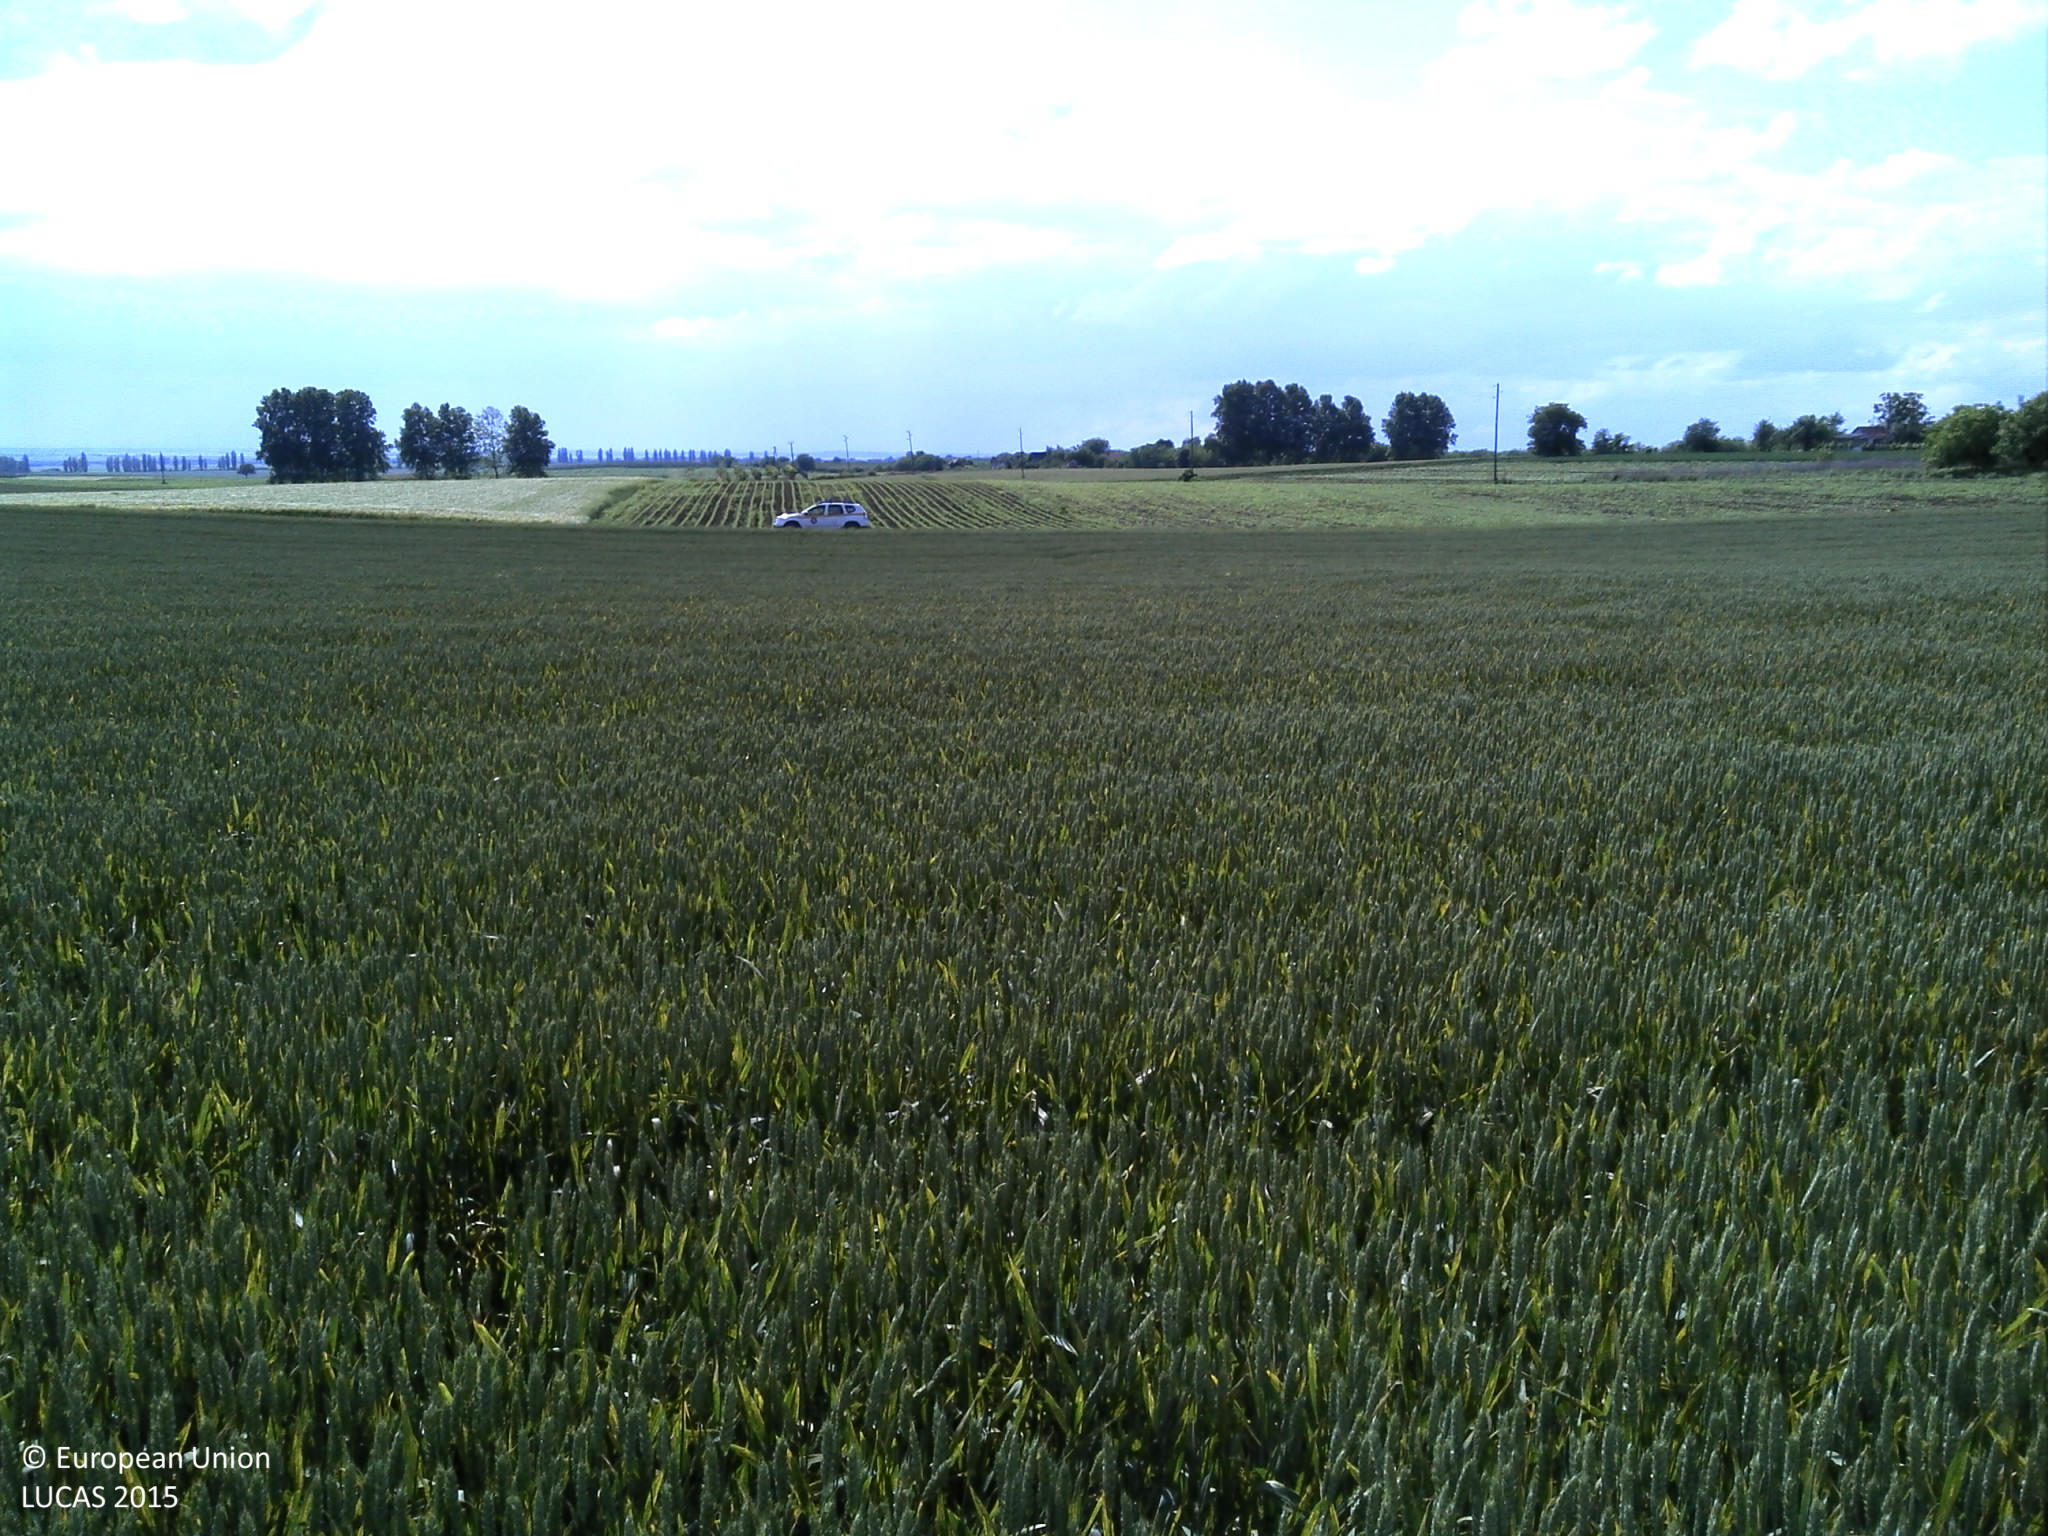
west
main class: Cropland
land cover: Common wheat
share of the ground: > 75 %
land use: Agriculture (excluding fallow land and kitchen gardens)
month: May
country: HR
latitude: 45.5217
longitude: 18.9583
